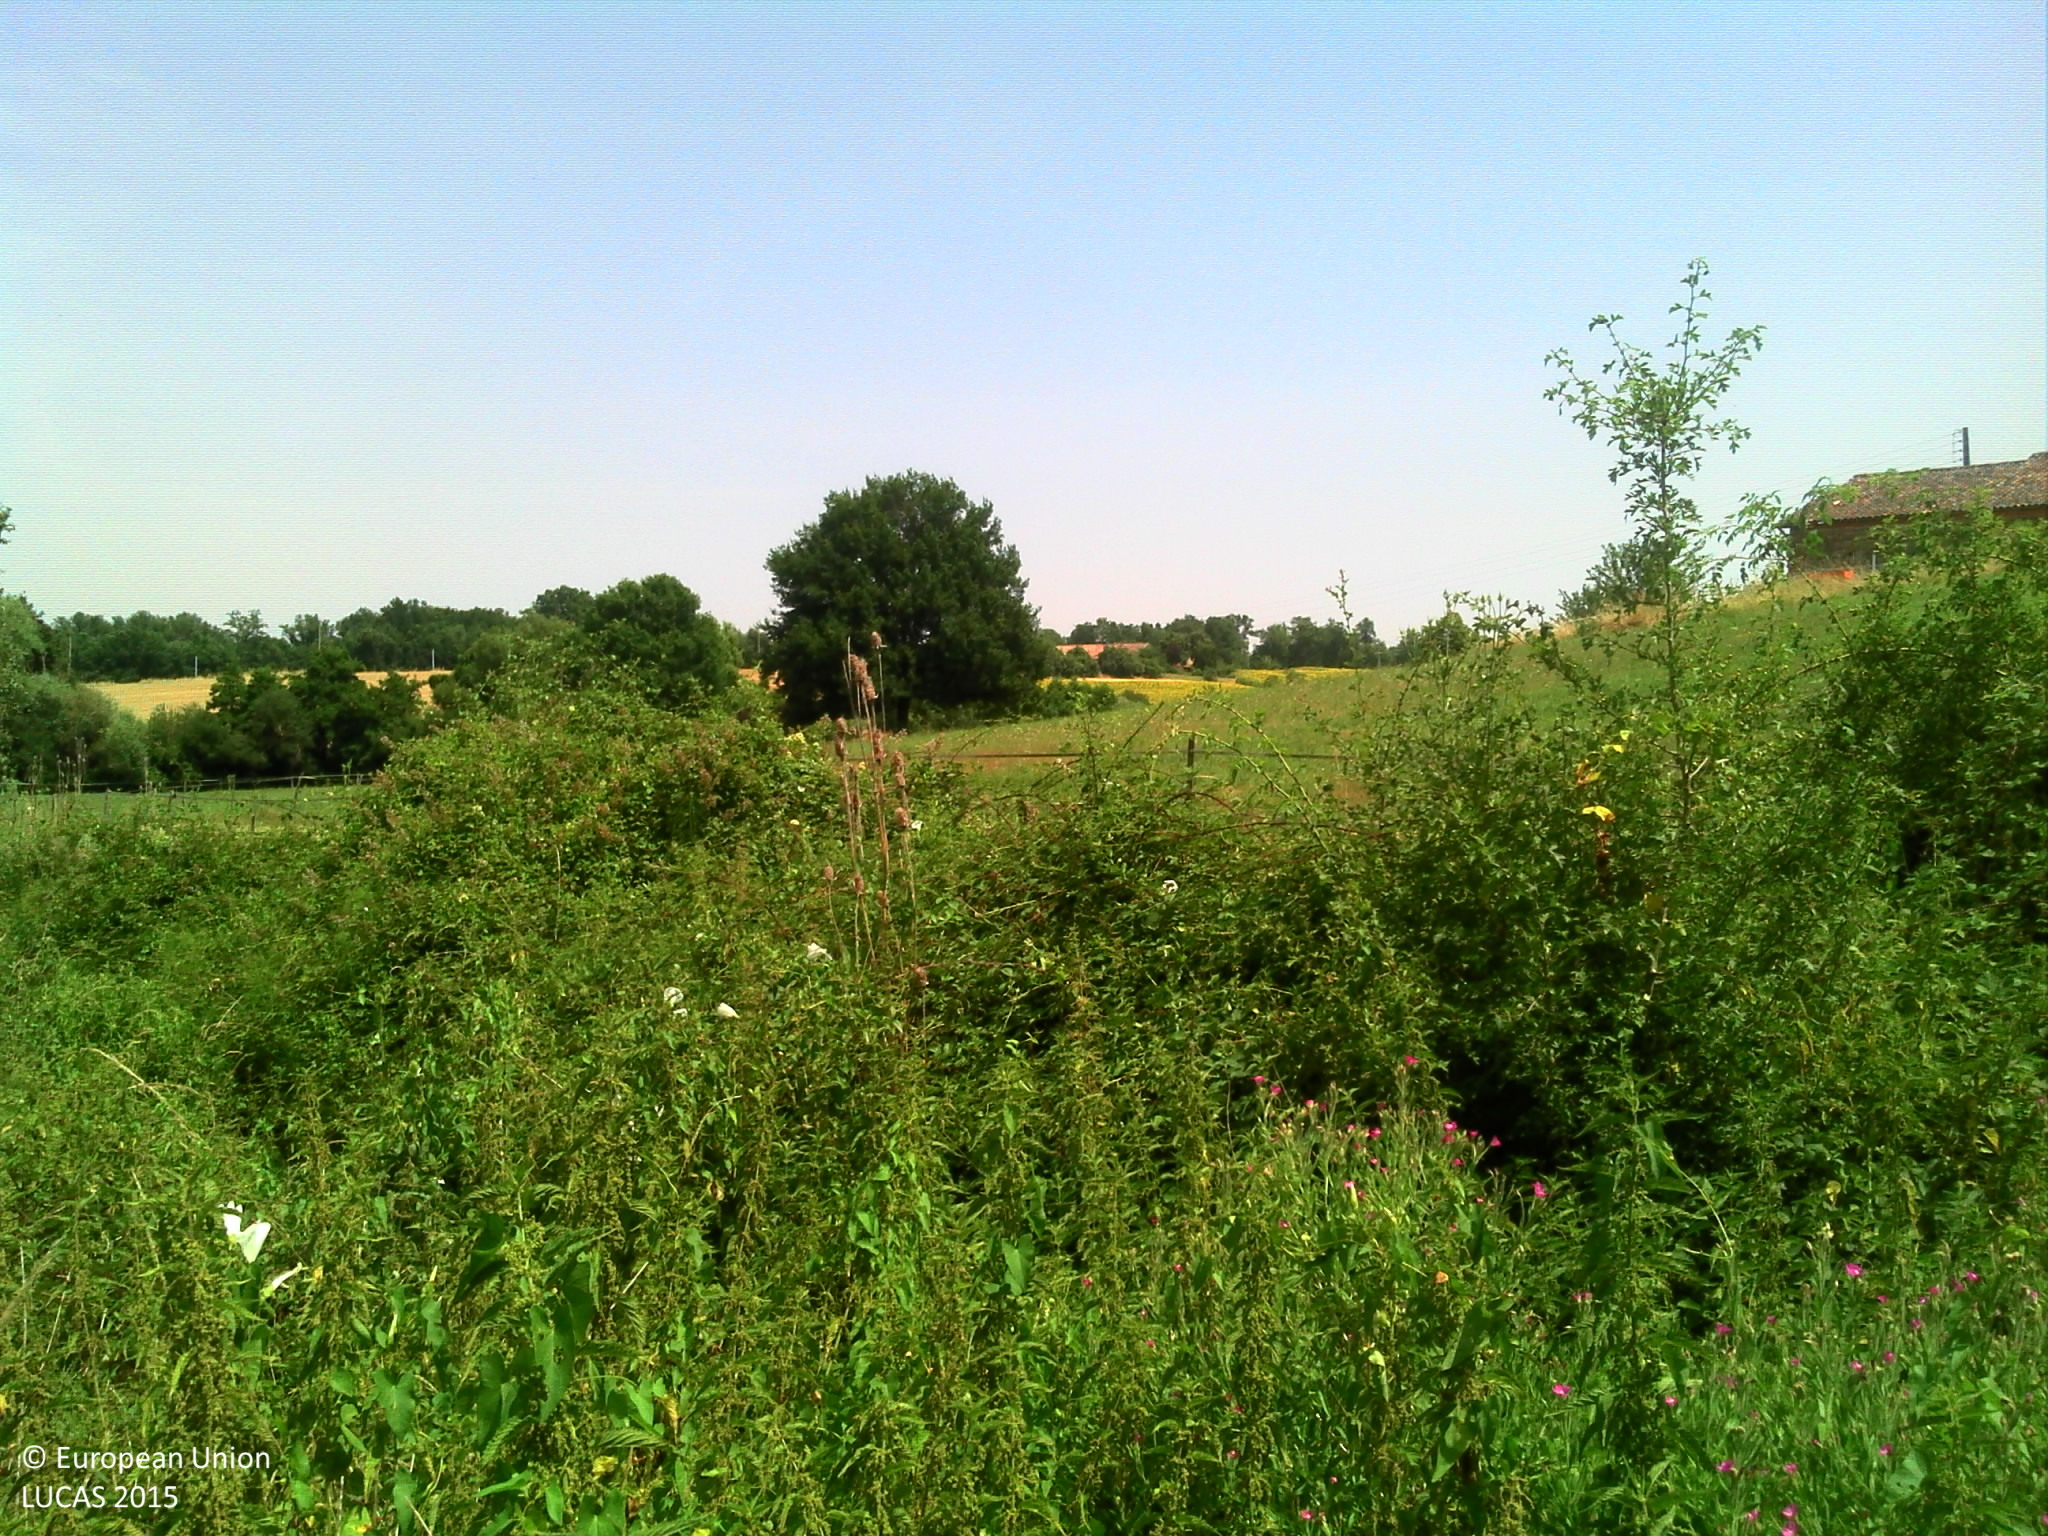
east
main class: Grassland
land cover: Grassland without tree/shrub cover
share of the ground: > 75 %
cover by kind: herbaceous plants 95 %, shrubs 5 %
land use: Agriculture (excluding fallow land and kitchen gardens)
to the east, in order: Grassland without tree/shrub cover; Ditches and canals; Grassland without tree/shrub cover; Tracks; Grassland without tree/shrub cover; Single bushes/trees; Grassland without tree/shrub cover; Electric lines; Grassland without tree/shrub cover; Fences; Lines of trees; Tracks; Lines of trees; Fences; Grassland without tree/shrub cover; Grass margins; Managed hedges; Ditches and canals; Grass margins; Common wheat
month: July
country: FR
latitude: 43.7214
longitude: 1.6240
